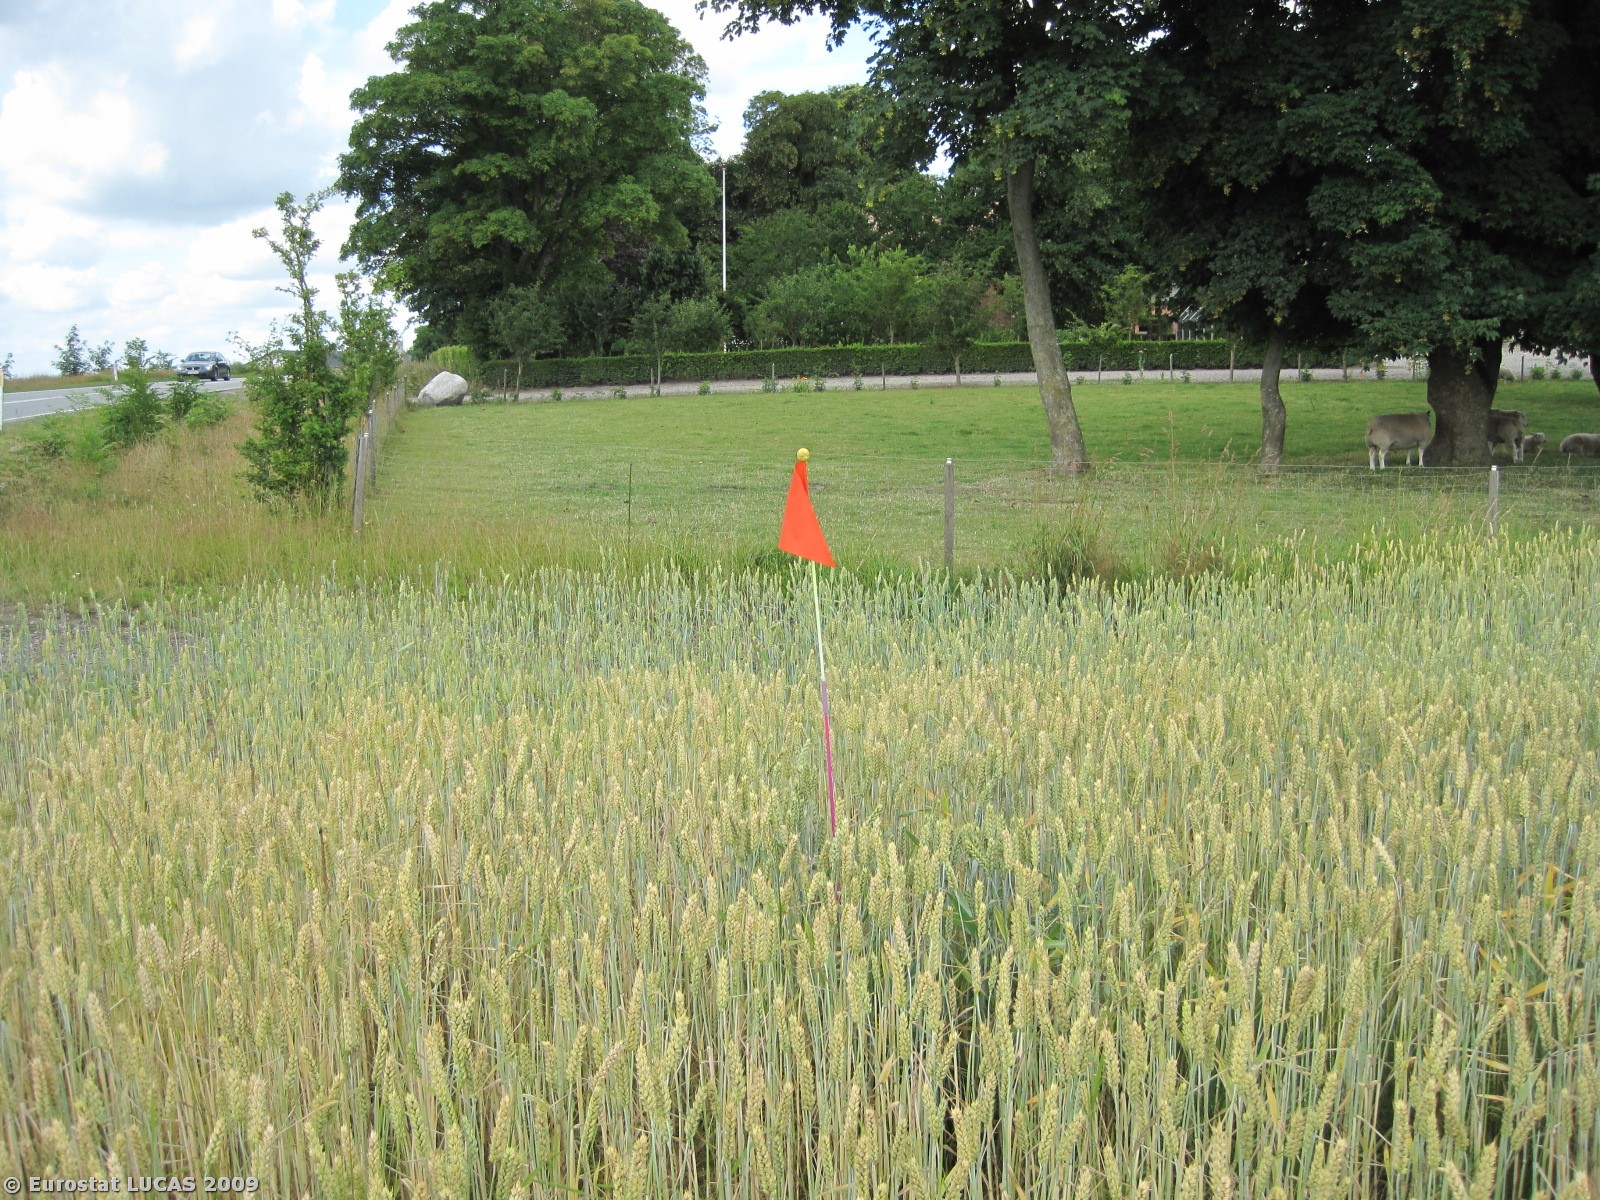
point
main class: Cropland
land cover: Common wheat
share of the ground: > 75 %
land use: Agriculture (excluding fallow land and kitchen gardens)
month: July
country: DK
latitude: 56.6727
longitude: 9.6904
